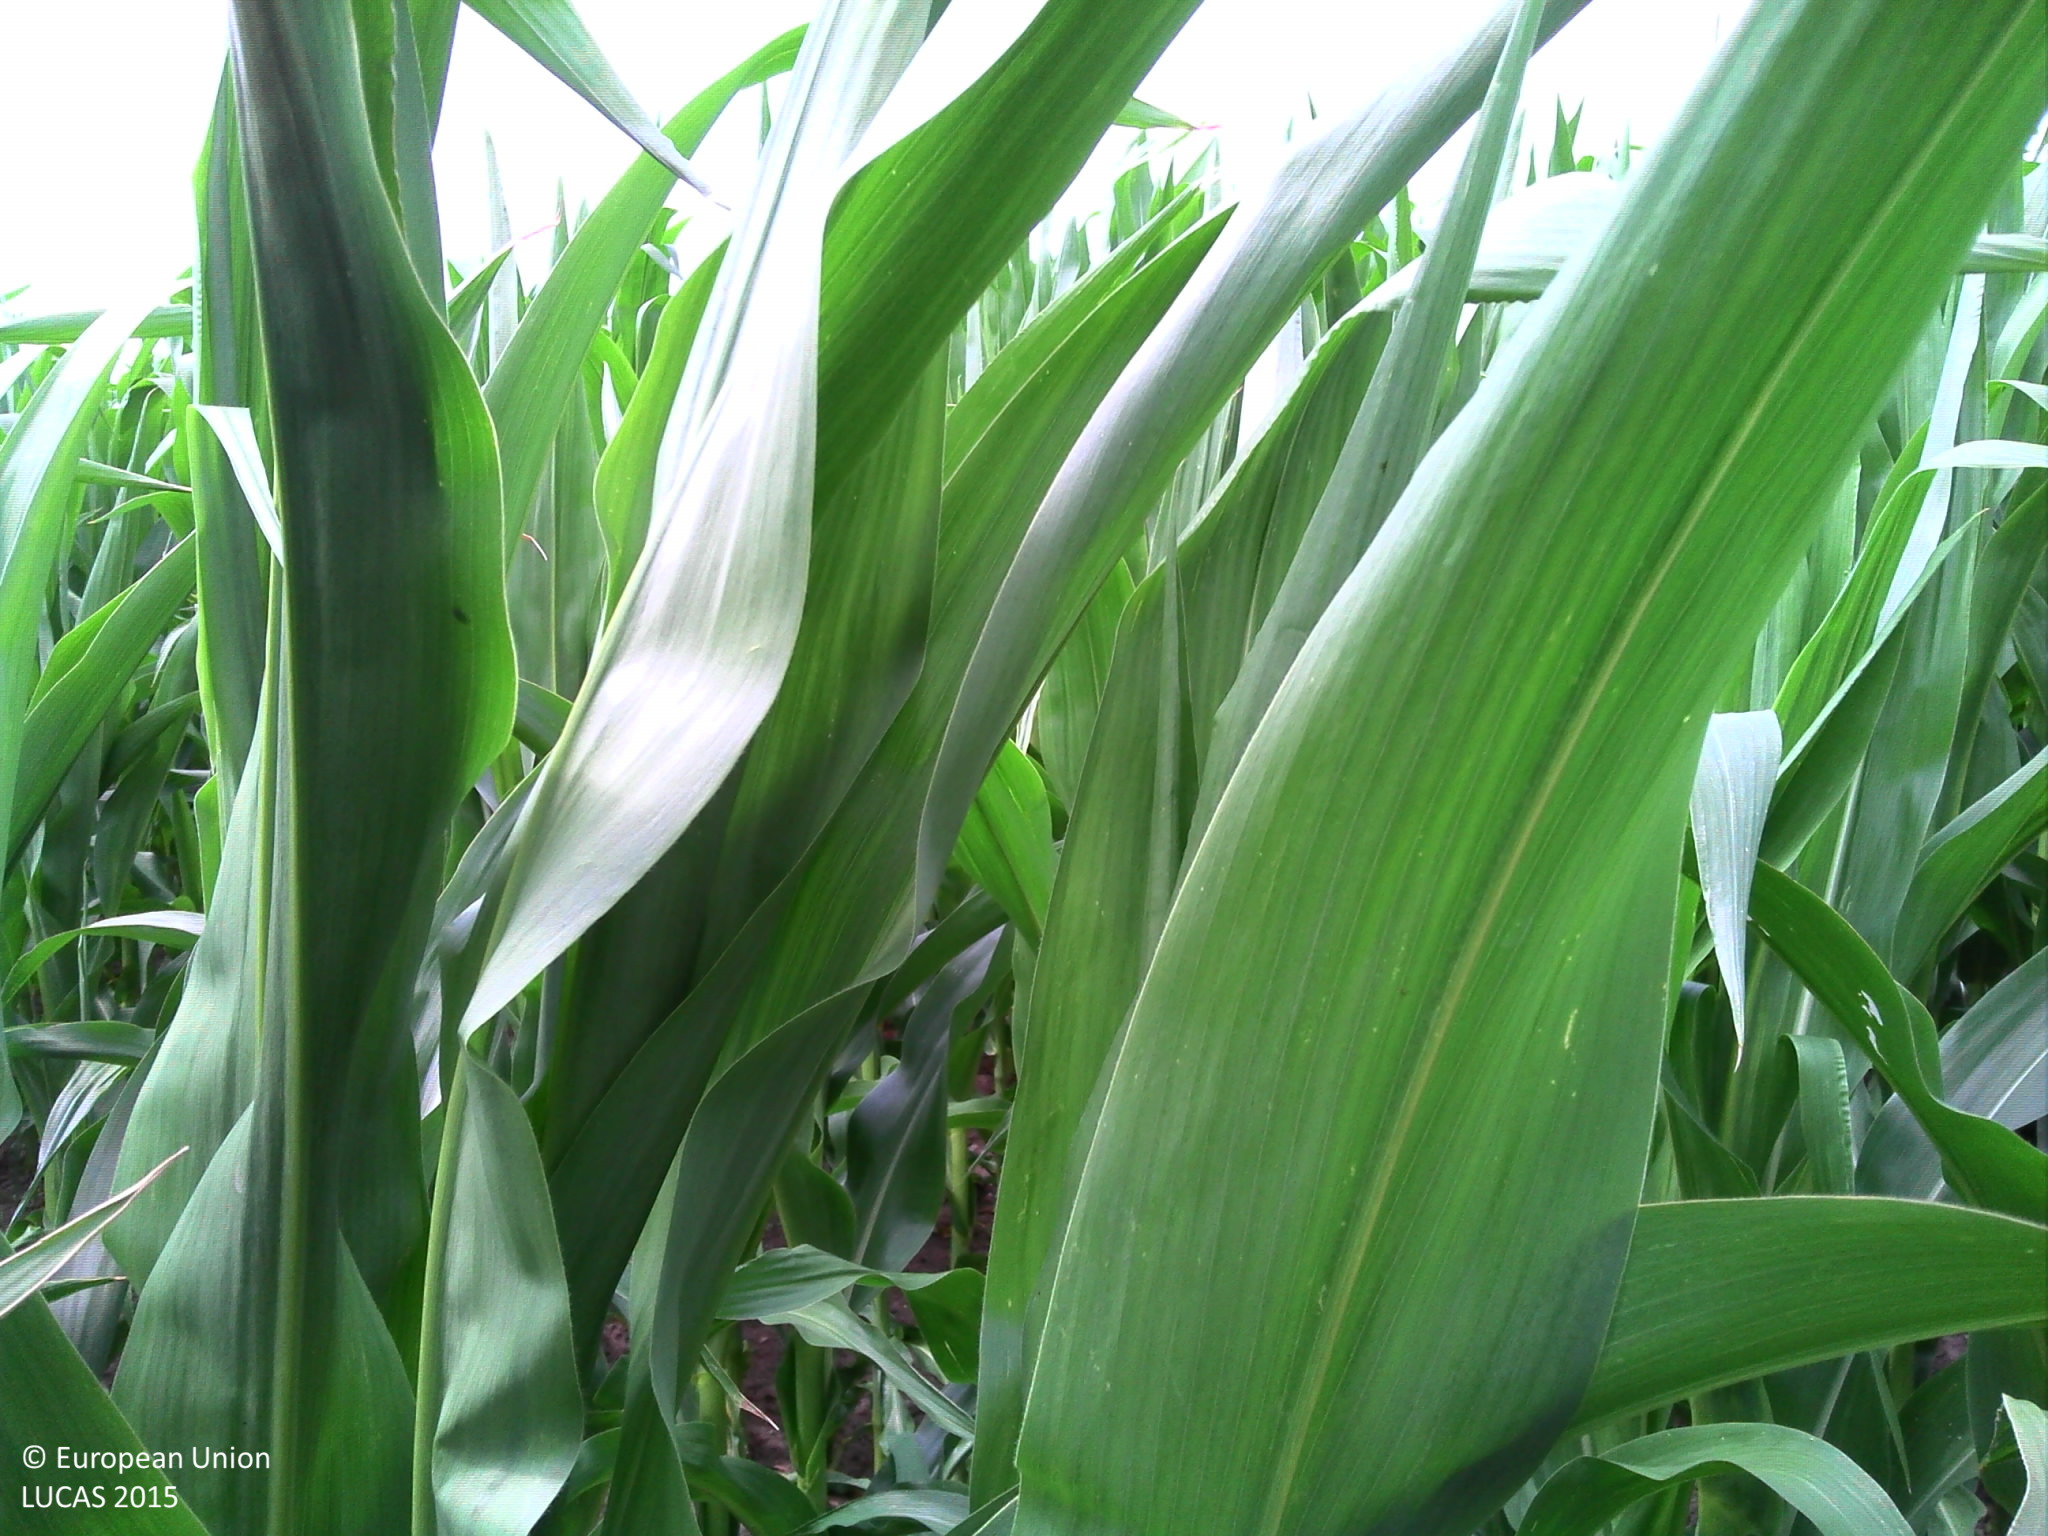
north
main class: Cropland
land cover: Maize
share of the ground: > 75 %
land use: Agriculture (excluding fallow land and kitchen gardens)
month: July
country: FR
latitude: 47.8377
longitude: -3.2586
